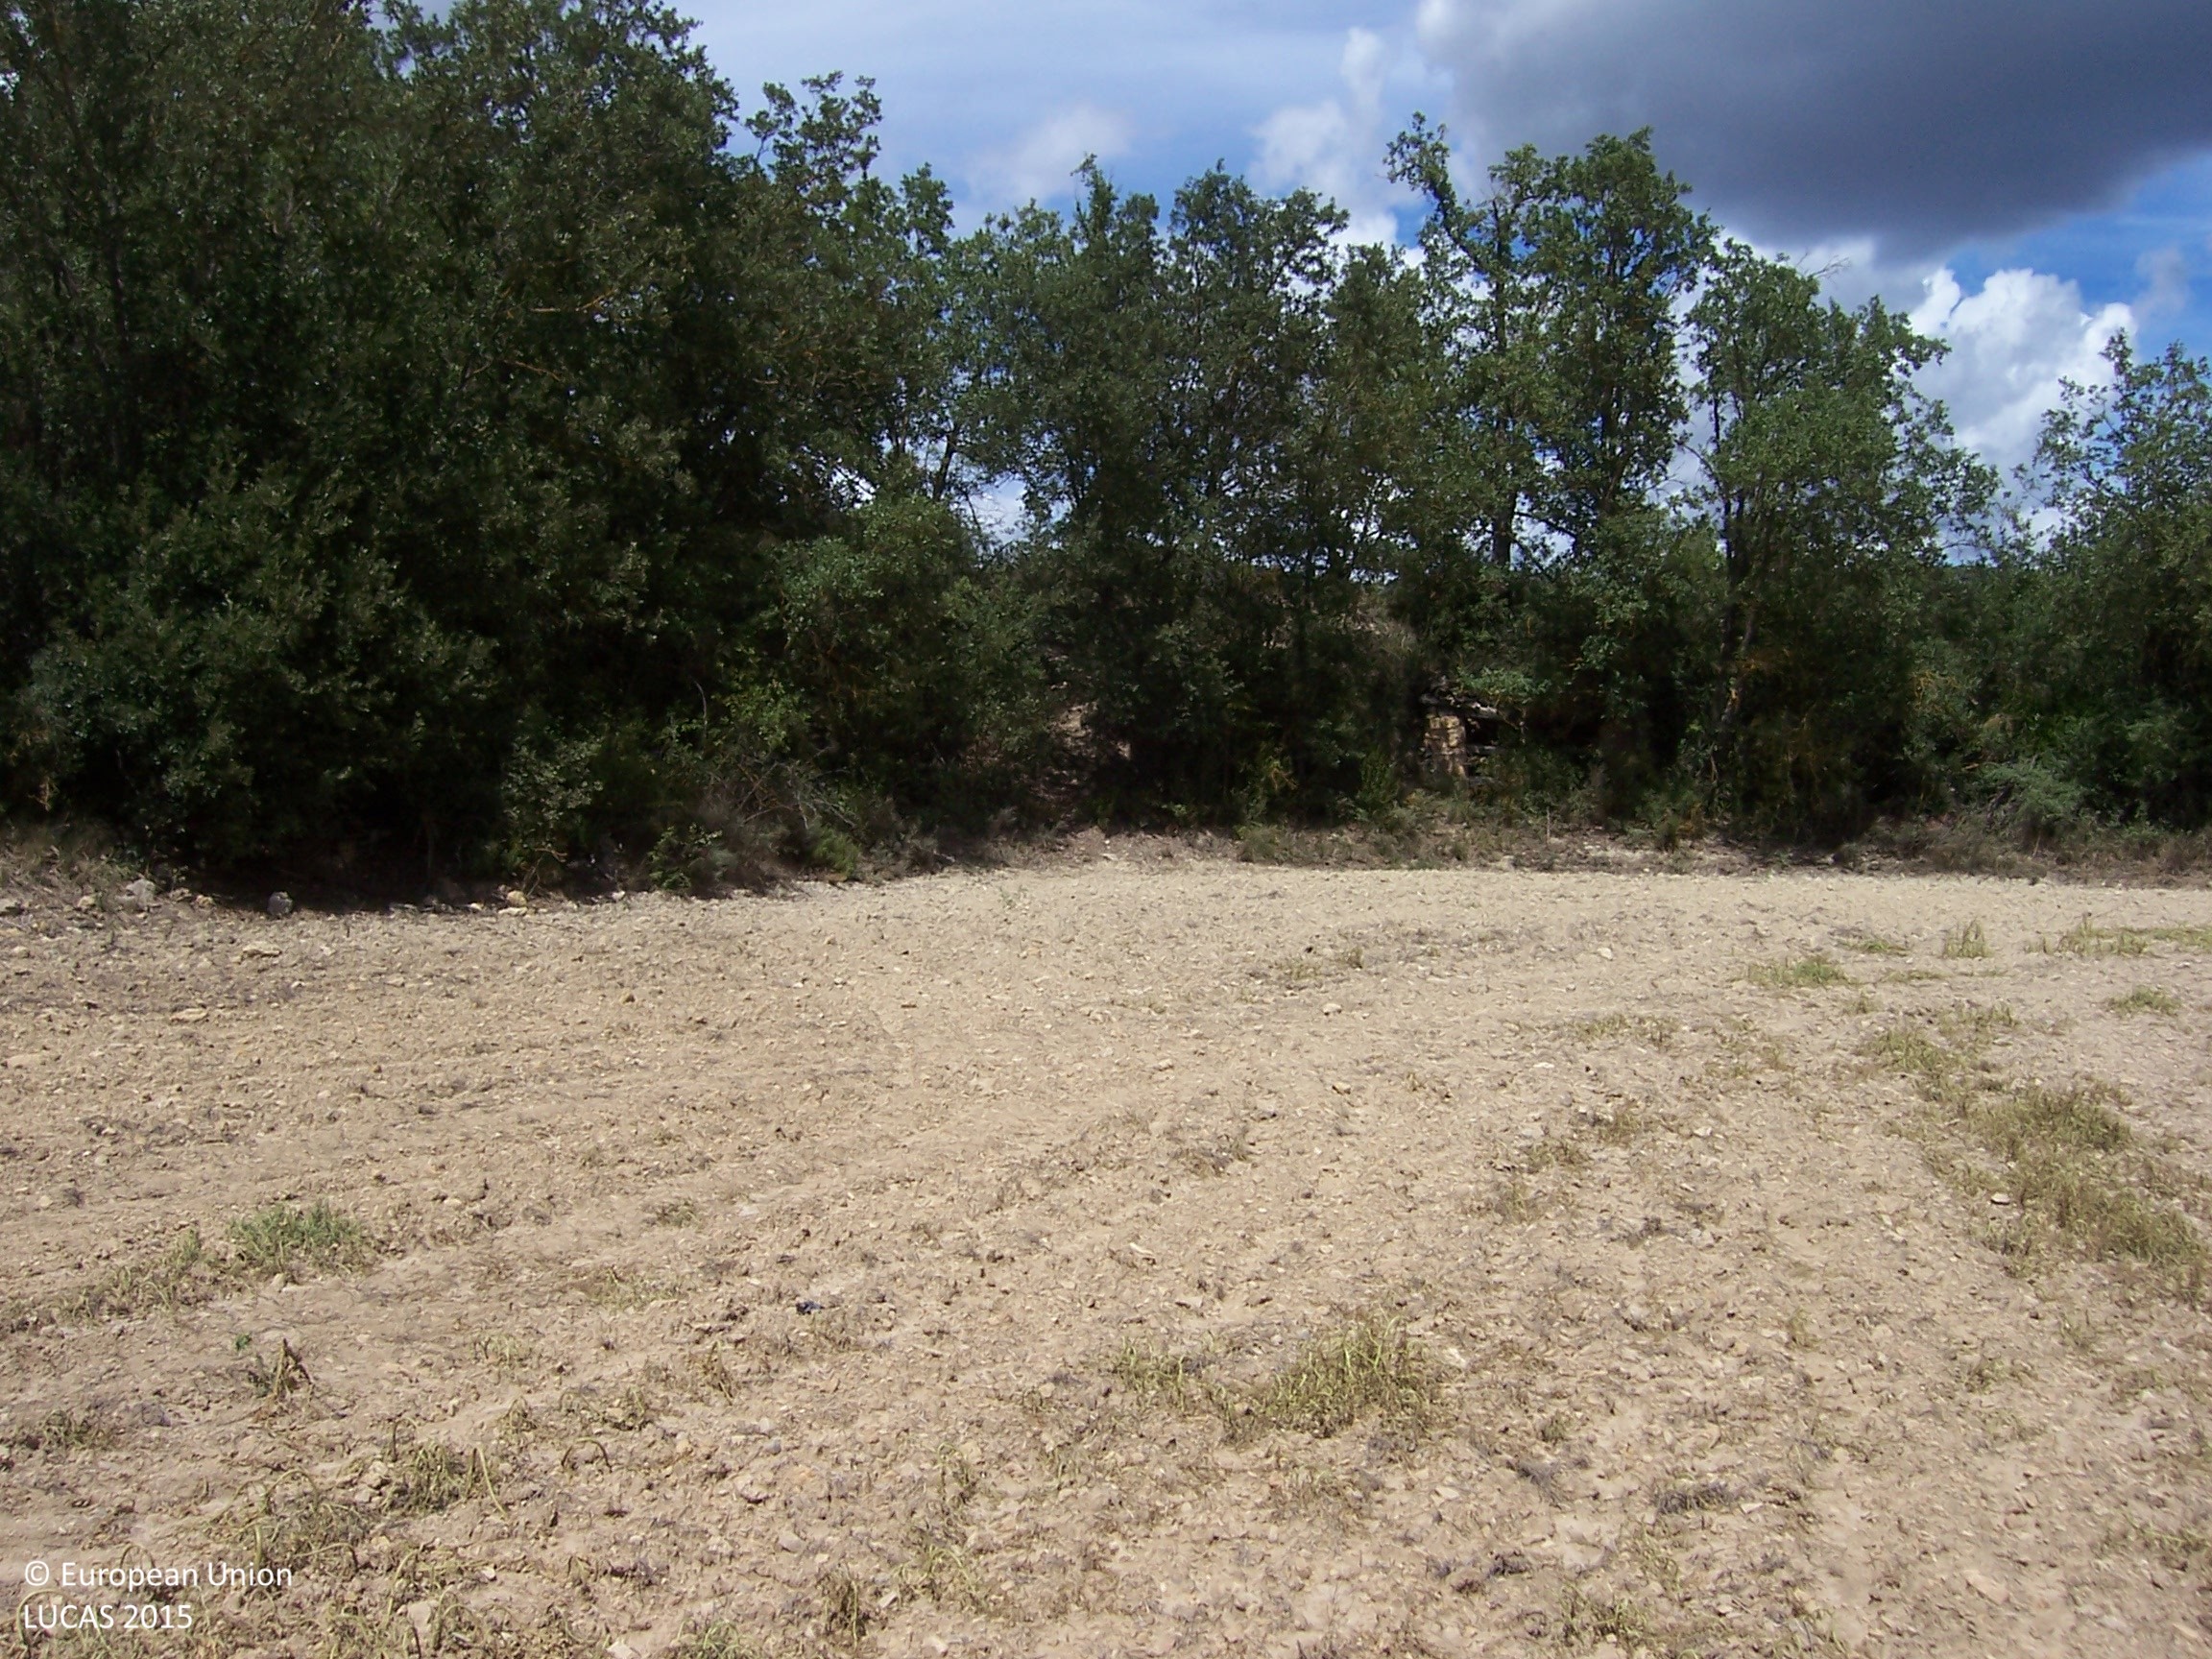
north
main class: Grassland
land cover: Spontaneously vegetated surfaces
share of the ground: > 75 %
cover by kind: unconsolidated bare surface 60 %, herbaceous plants 40 %
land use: Fallow land
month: August
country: ES
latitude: 42.0274
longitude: 0.5270
